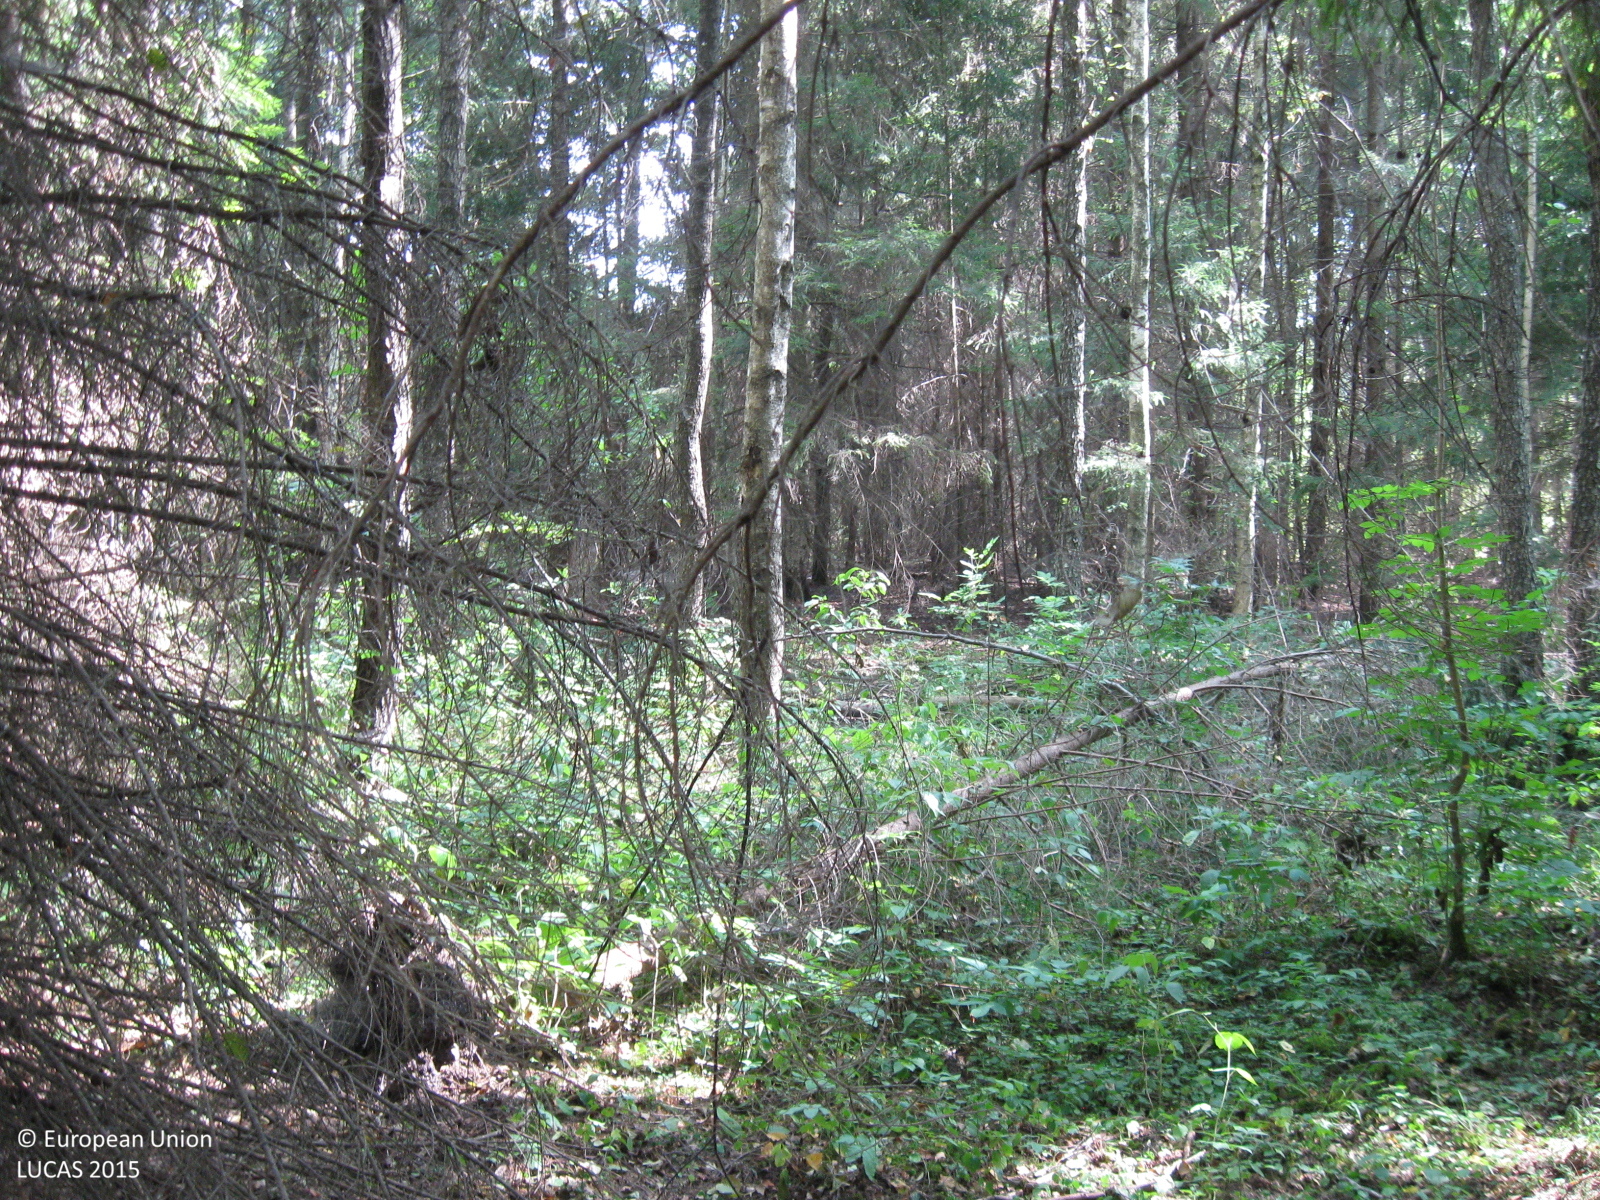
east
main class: Woodland
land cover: Spruce dominated mixed woodland
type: hemiboreal forest and nemoral coniferous forest and mixed broadleaved-coniferous forest
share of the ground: > 75 %
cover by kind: broadleaved forest trees 65 %, coniferous forest trees 30 %, herbaceous plants 5 %
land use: Forestry
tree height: > 5 m
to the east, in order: Spruce dominated mixed woodland; Spruce dominated coniferous woodland; Spruce dominated mixed woodland
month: August
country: LT
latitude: 55.2106
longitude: 22.8445
